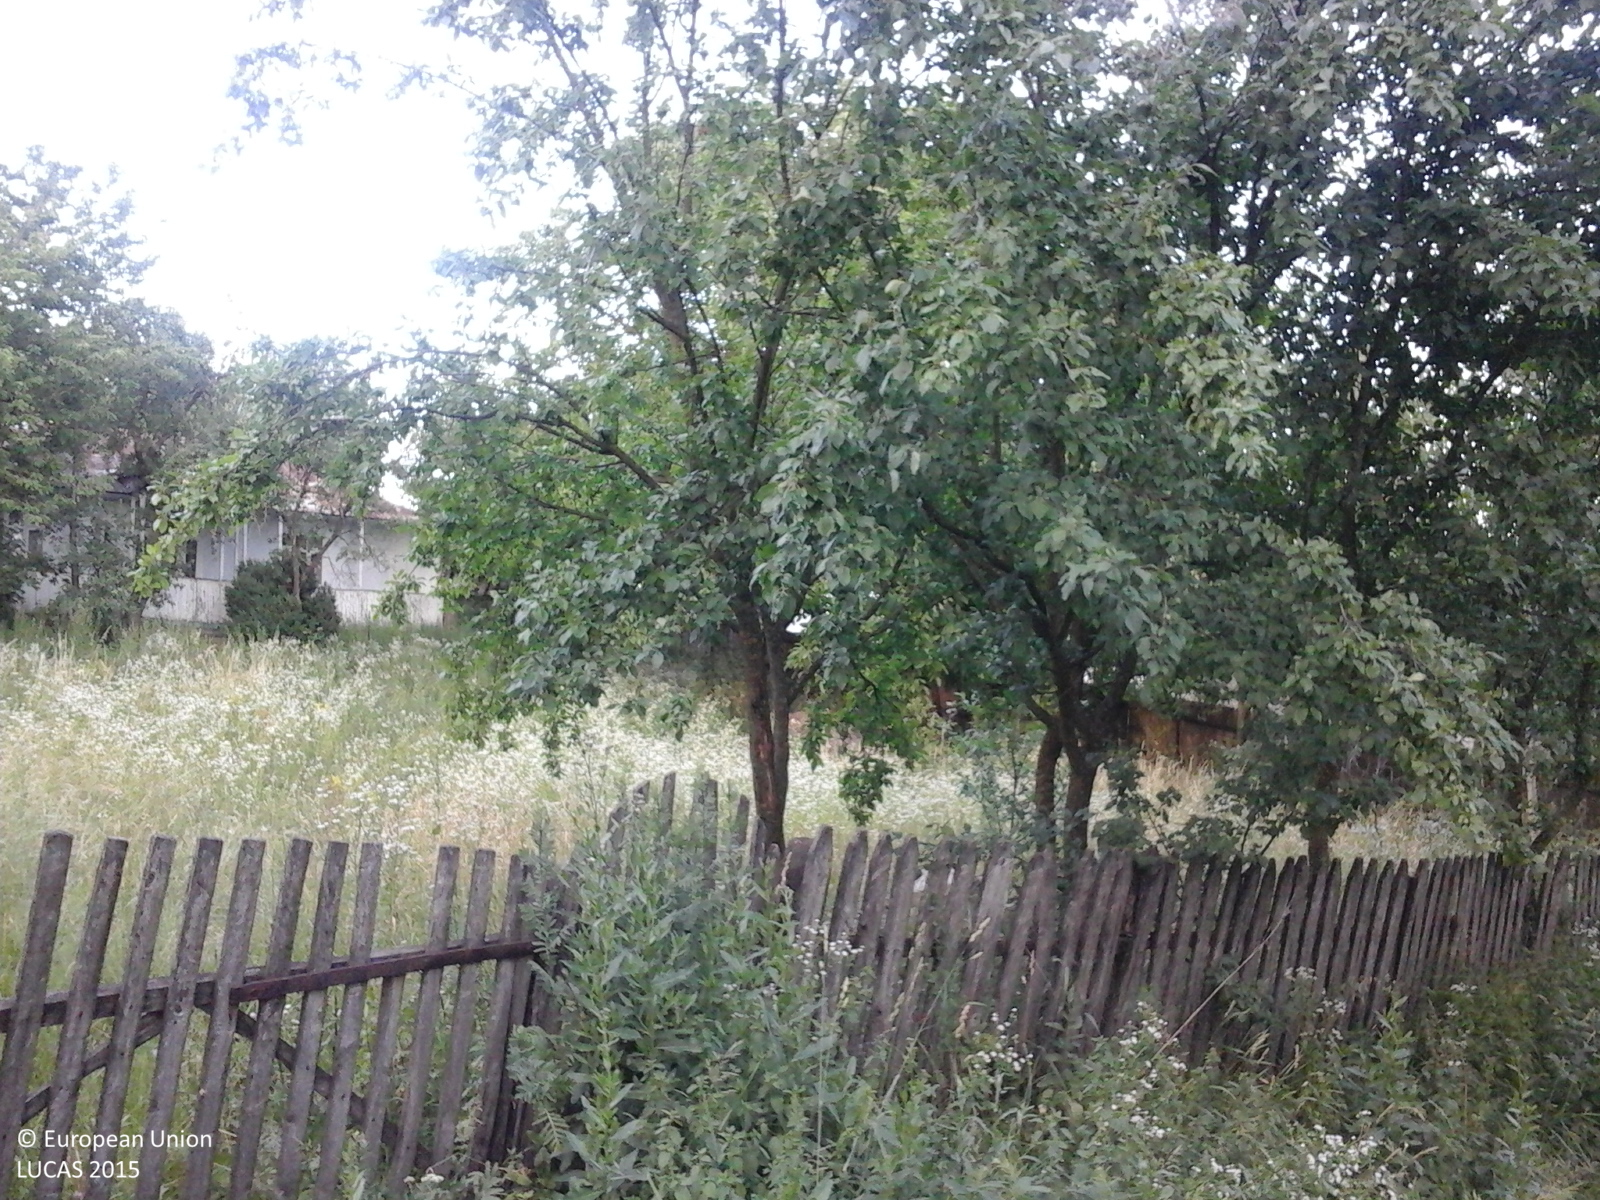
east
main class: Grassland
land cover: Grassland without tree/shrub cover
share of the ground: > 75 %
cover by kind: herbaceous plants 100 %
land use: Agriculture (excluding fallow land and kitchen gardens)
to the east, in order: Grassland without tree/shrub cover; Artificial constructions in urban areas; Arable land (only in case pi); Artificial constructions in urban areas; Maize; Dry pulses; Lucerne; Single bushes/trees; Maize; Potatoes; Maize; Oats
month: June
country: RO
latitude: 48.2015
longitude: 26.6054
